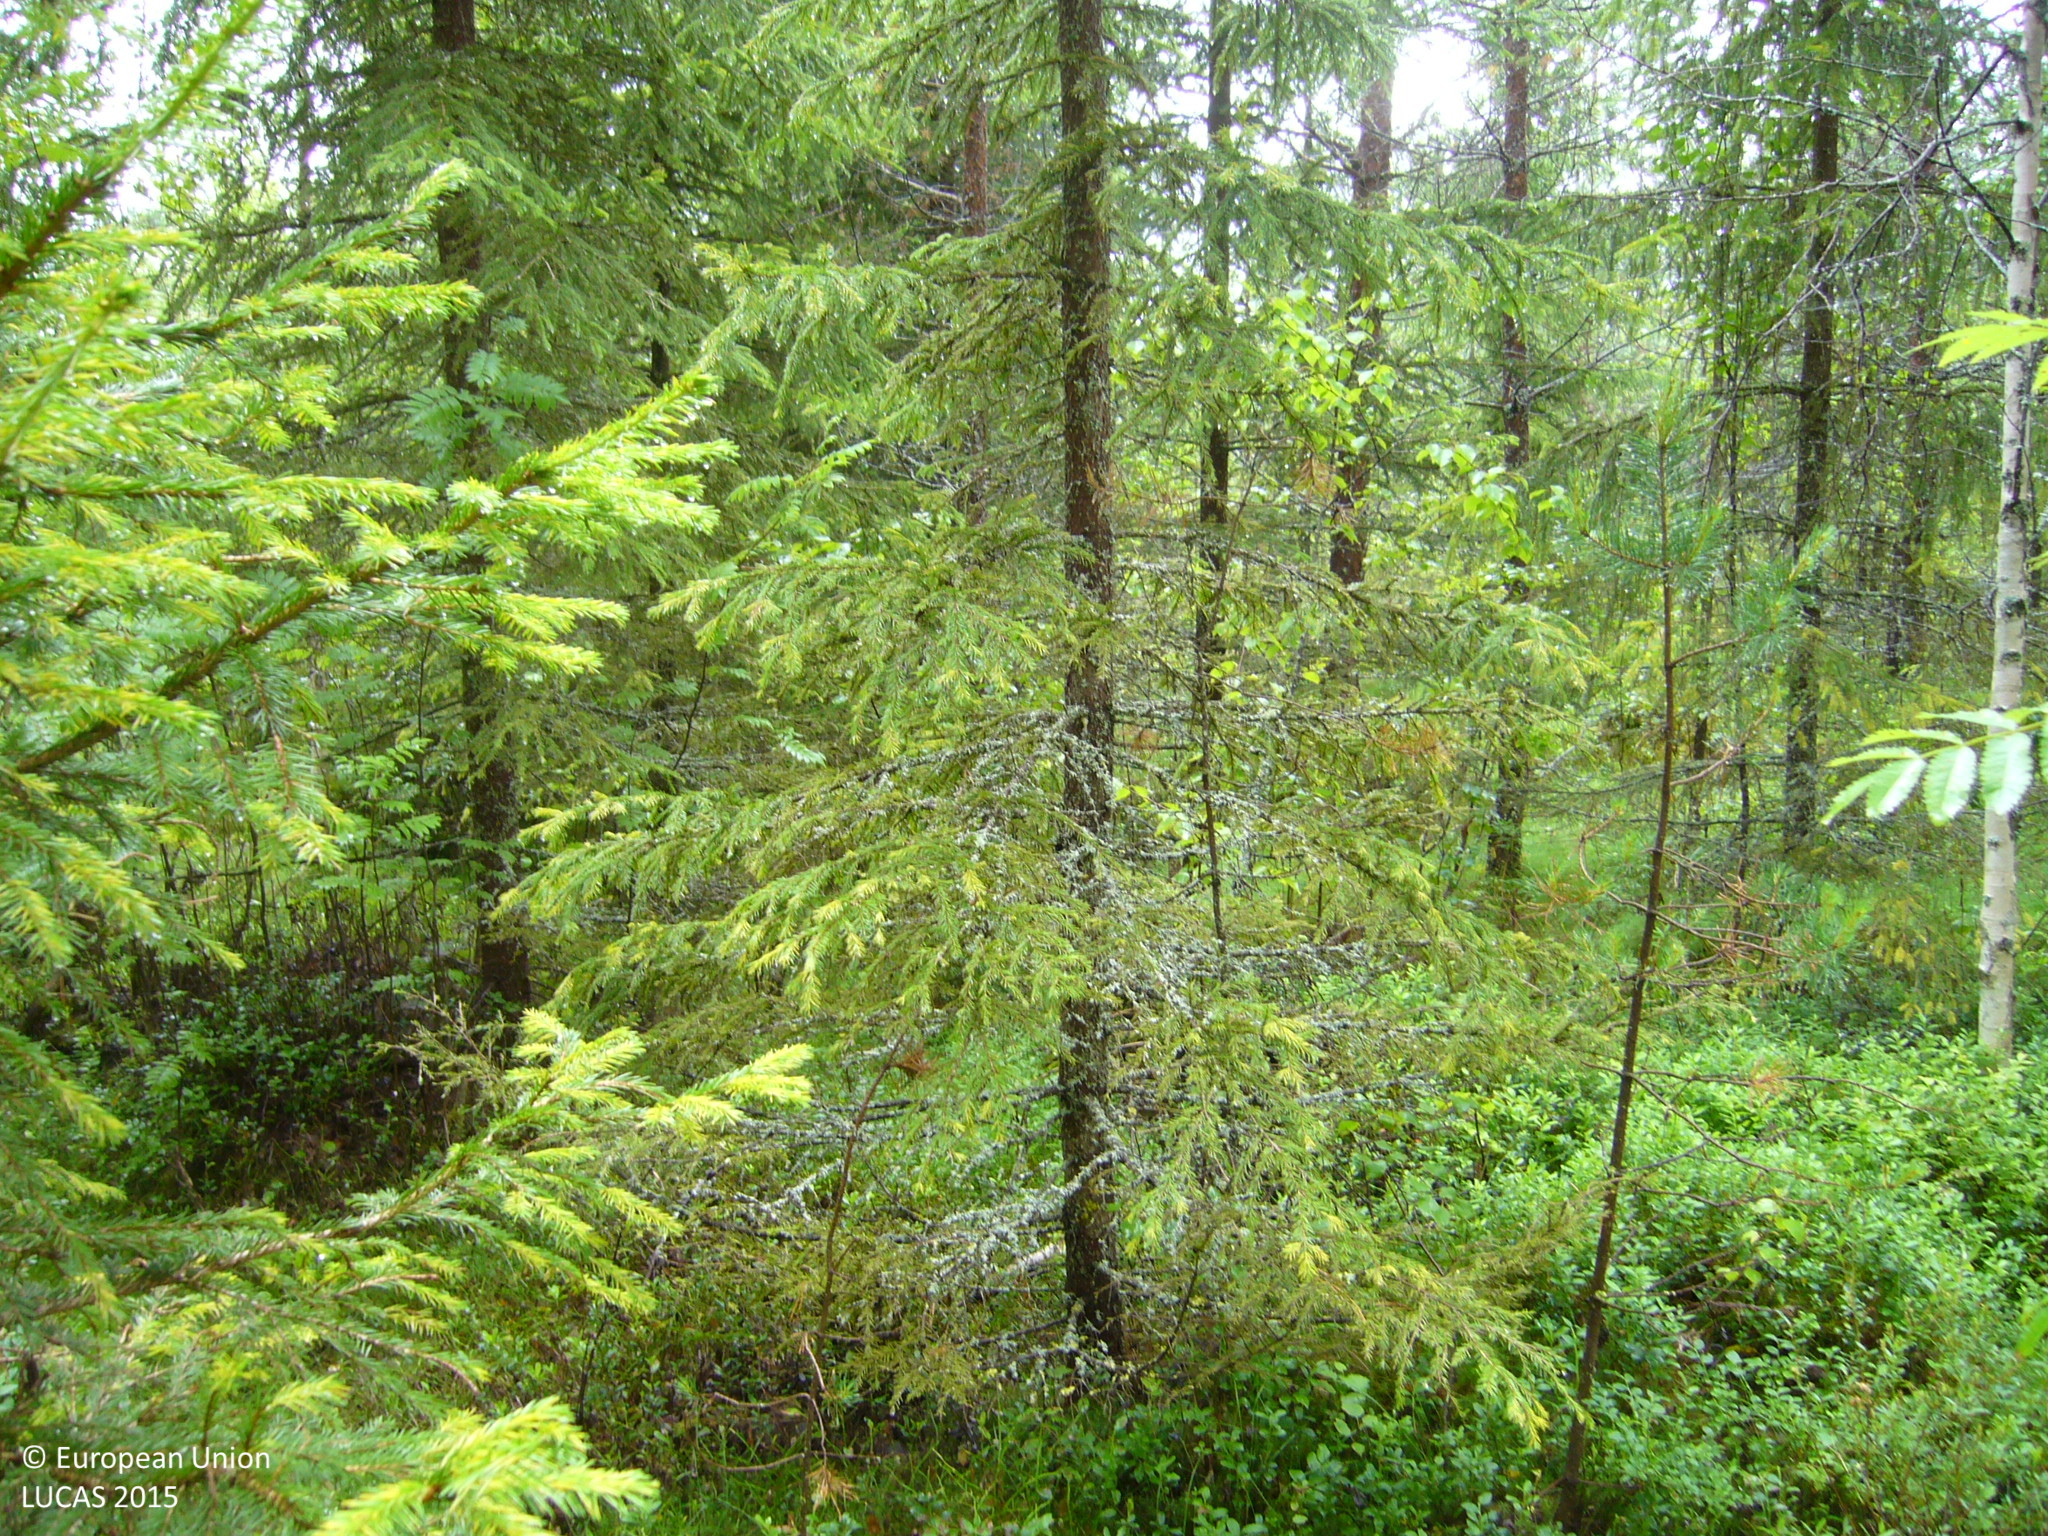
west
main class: Woodland
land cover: Other mixed woodland
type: boreal forest
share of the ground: > 75 %
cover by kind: broadleaved forest trees 45 %, coniferous forest trees 35 %, shrubs 20 %
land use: Forestry
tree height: > 5 m
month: July
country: FI
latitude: 63.8214
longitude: 25.9763
